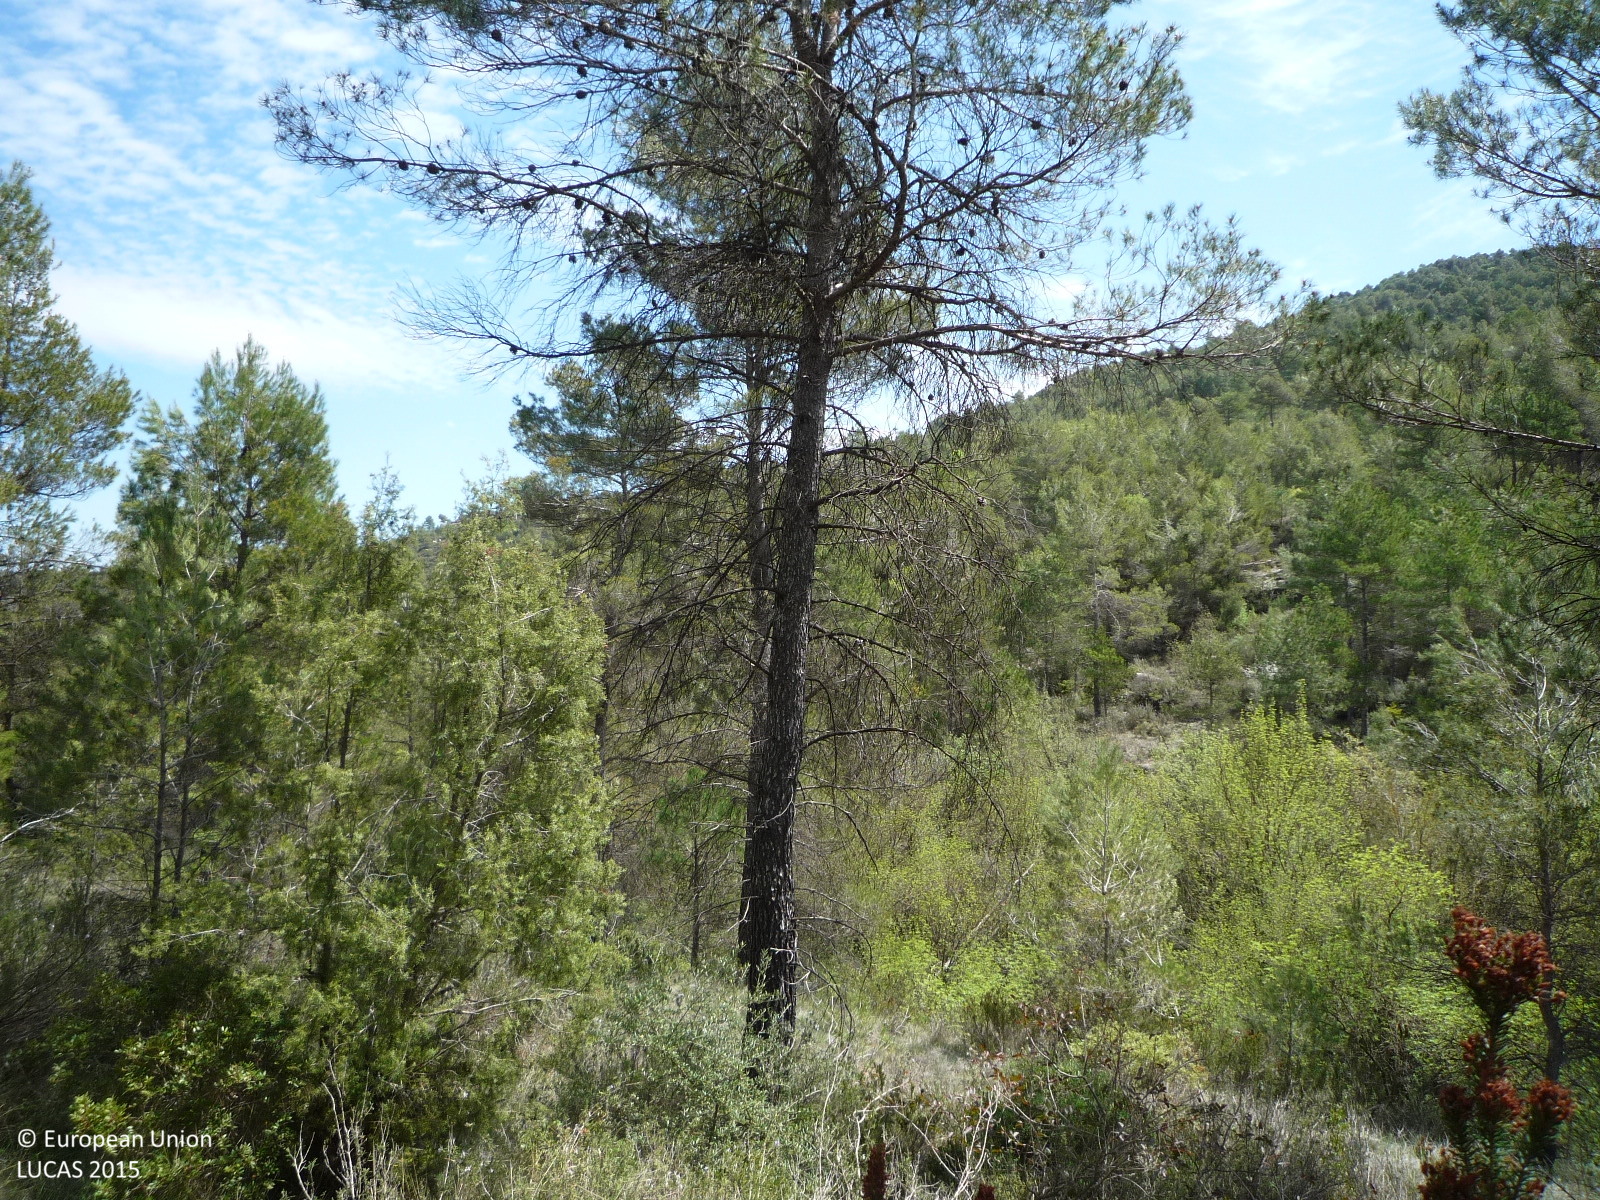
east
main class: Woodland
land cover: Pine dominated coniferous woodland
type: coniferous forest of the mediterranean region
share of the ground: > 75 %
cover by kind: coniferous forest trees 65 %, shrubs 25 %, herbaceous plants 10 %
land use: Forestry
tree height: > 5 m
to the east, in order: Pine dominated coniferous woodland; Tracks; Pine dominated coniferous woodland; Rock outcrops; Broadleaved woodland; Rivers and streams; Broadleaved woodland; Tracks; Pine dominated mixed woodland; Pine dominated coniferous woodland; Rock outcrops; Pine dominated coniferous woodland
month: April
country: ES
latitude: 41.7267
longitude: 1.6357
